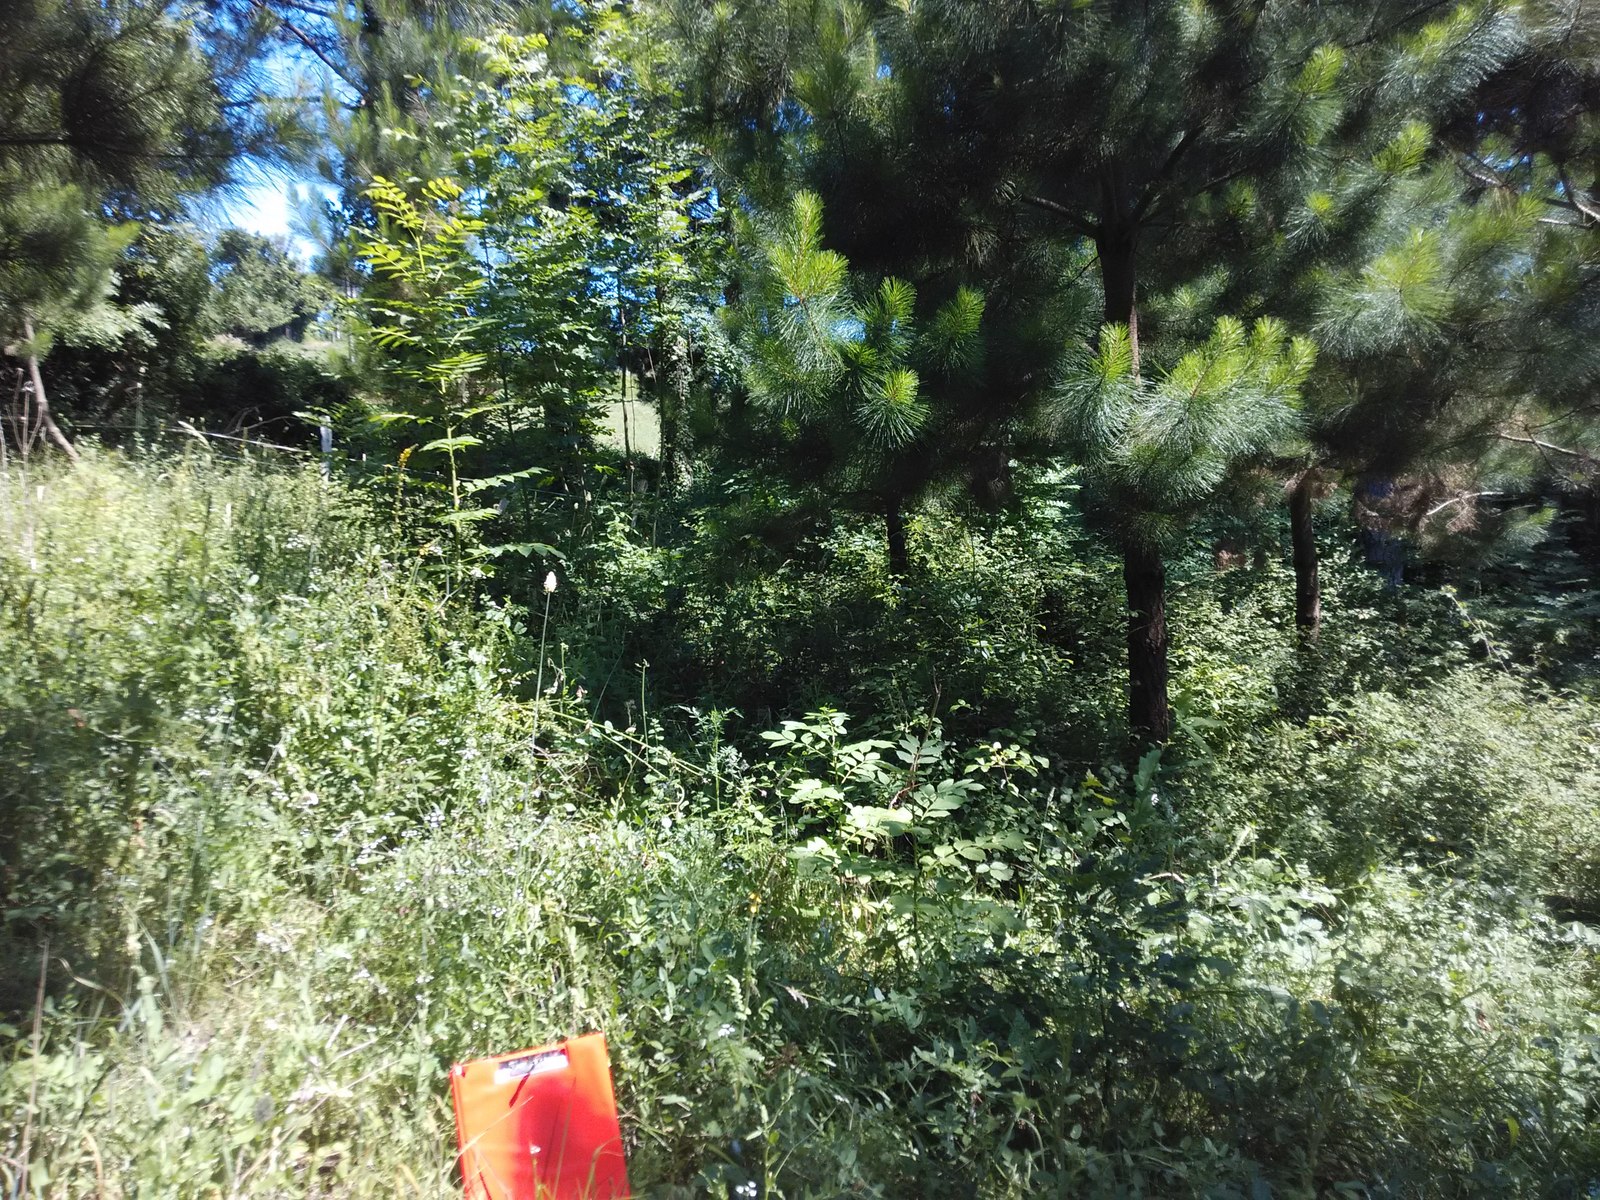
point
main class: Woodland
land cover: Pine dominated coniferous woodland
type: exotic forest
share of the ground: > 75 %
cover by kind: coniferous forest trees 80 %, herbaceous plants 15 %, shrubs 5 %
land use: Forestry
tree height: < 5 m
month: June
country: ES
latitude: 43.0430
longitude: -2.5105
